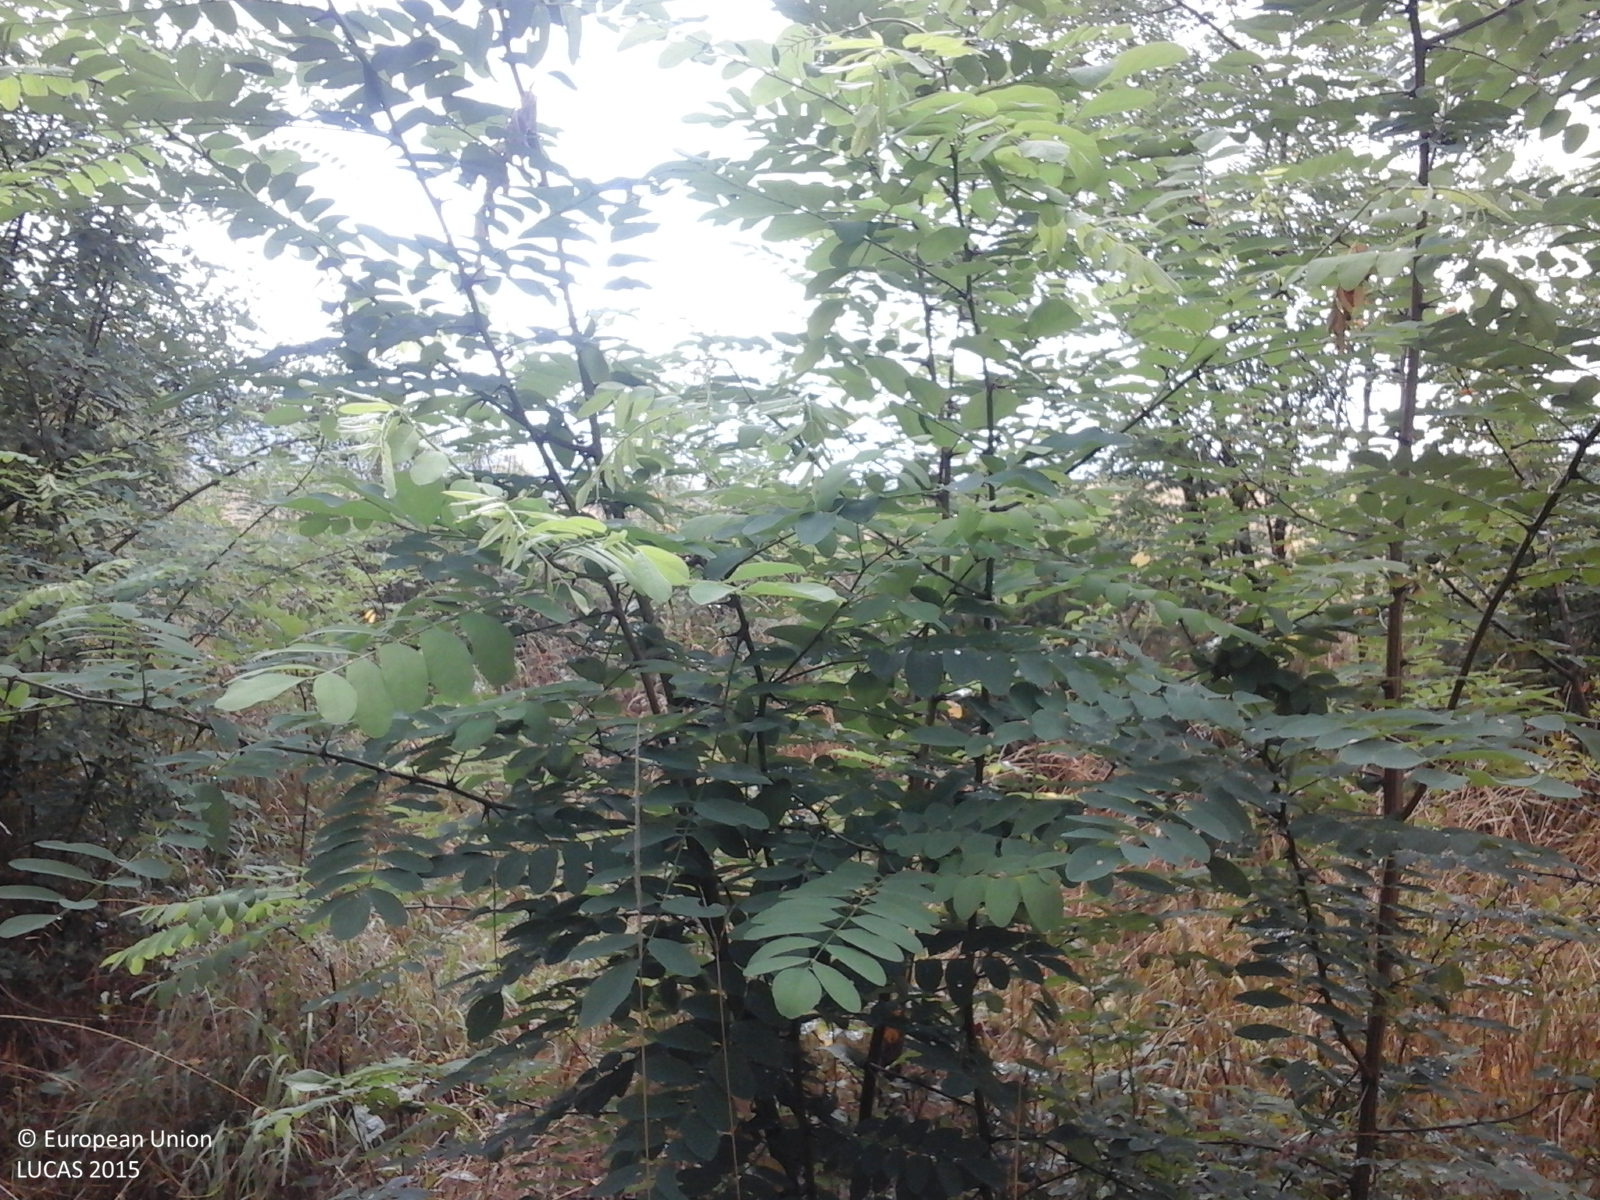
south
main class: Woodland
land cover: Broadleaved woodland
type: exotic forest
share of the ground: > 75 %
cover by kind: broadleaved forest trees 100 %
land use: Forestry
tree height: > 5 m
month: August
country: RO
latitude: 44.8962
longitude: 22.1038
